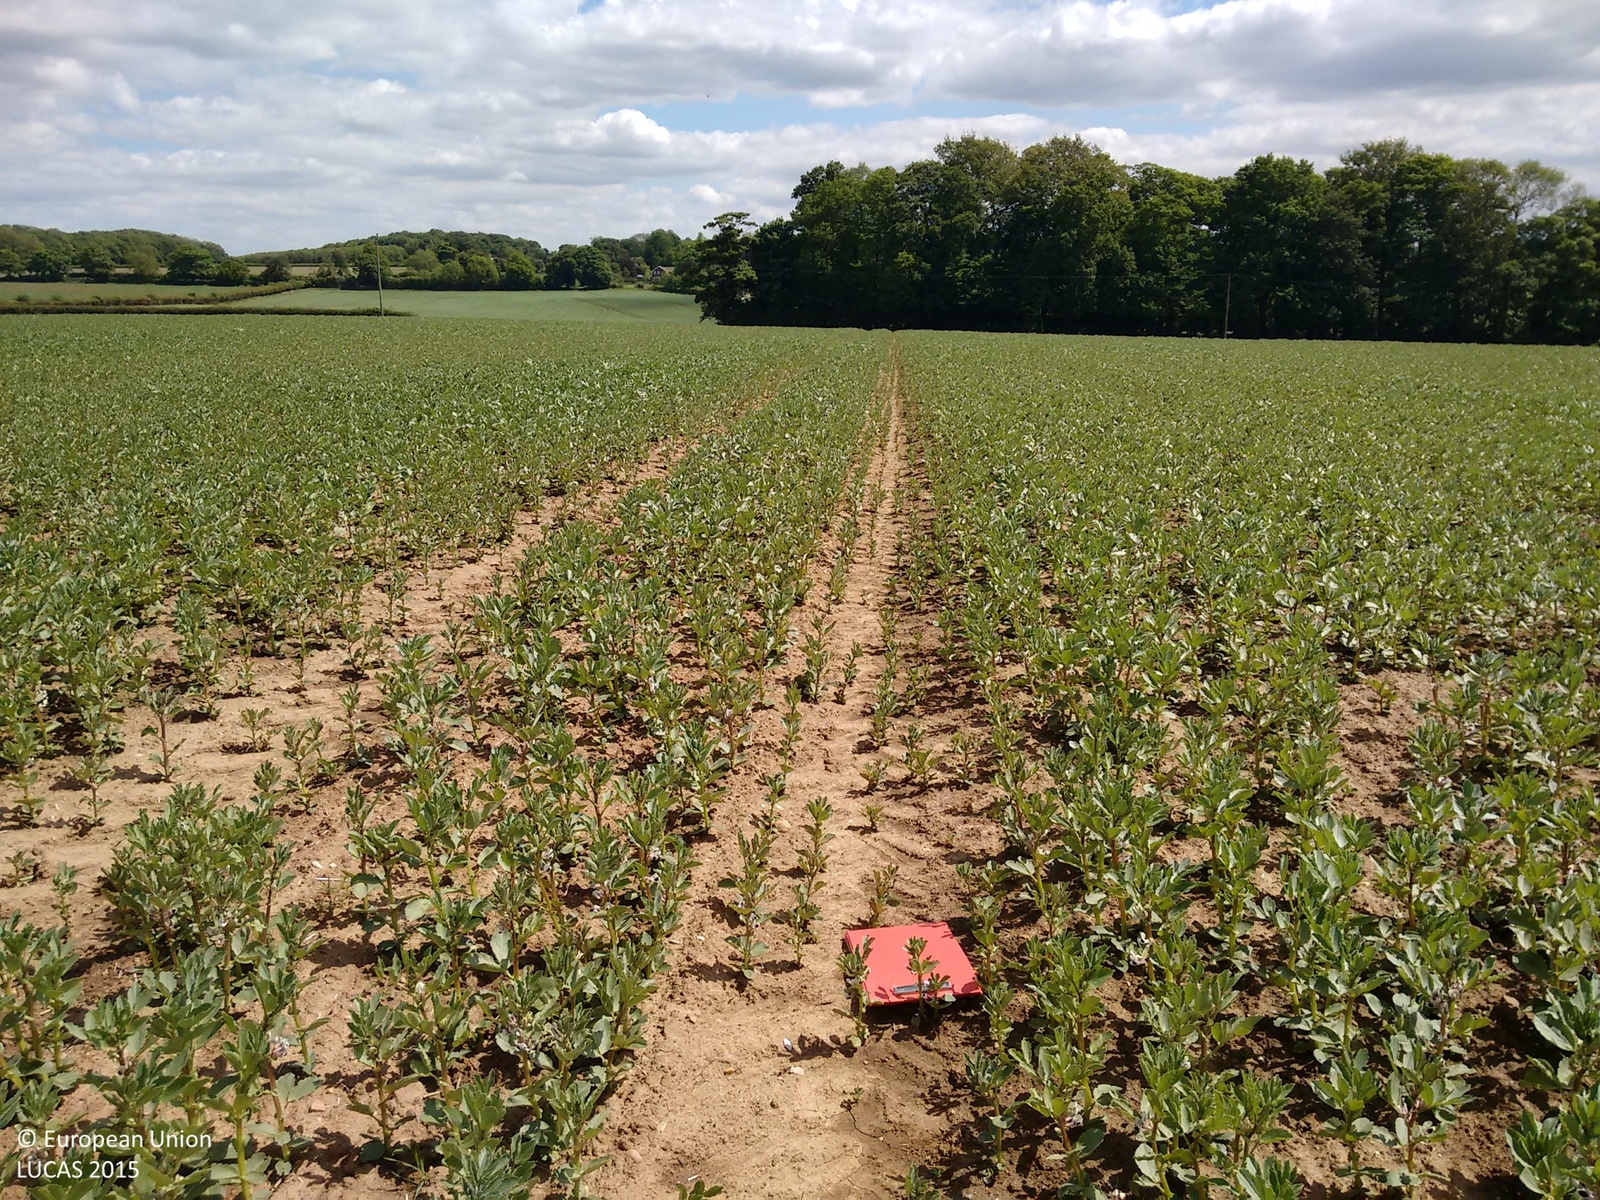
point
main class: Cropland
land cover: Dry pulses
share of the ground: 50 - 75 %
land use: Agriculture (excluding fallow land and kitchen gardens)
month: June
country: GB
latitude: 53.4823
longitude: -0.1447
